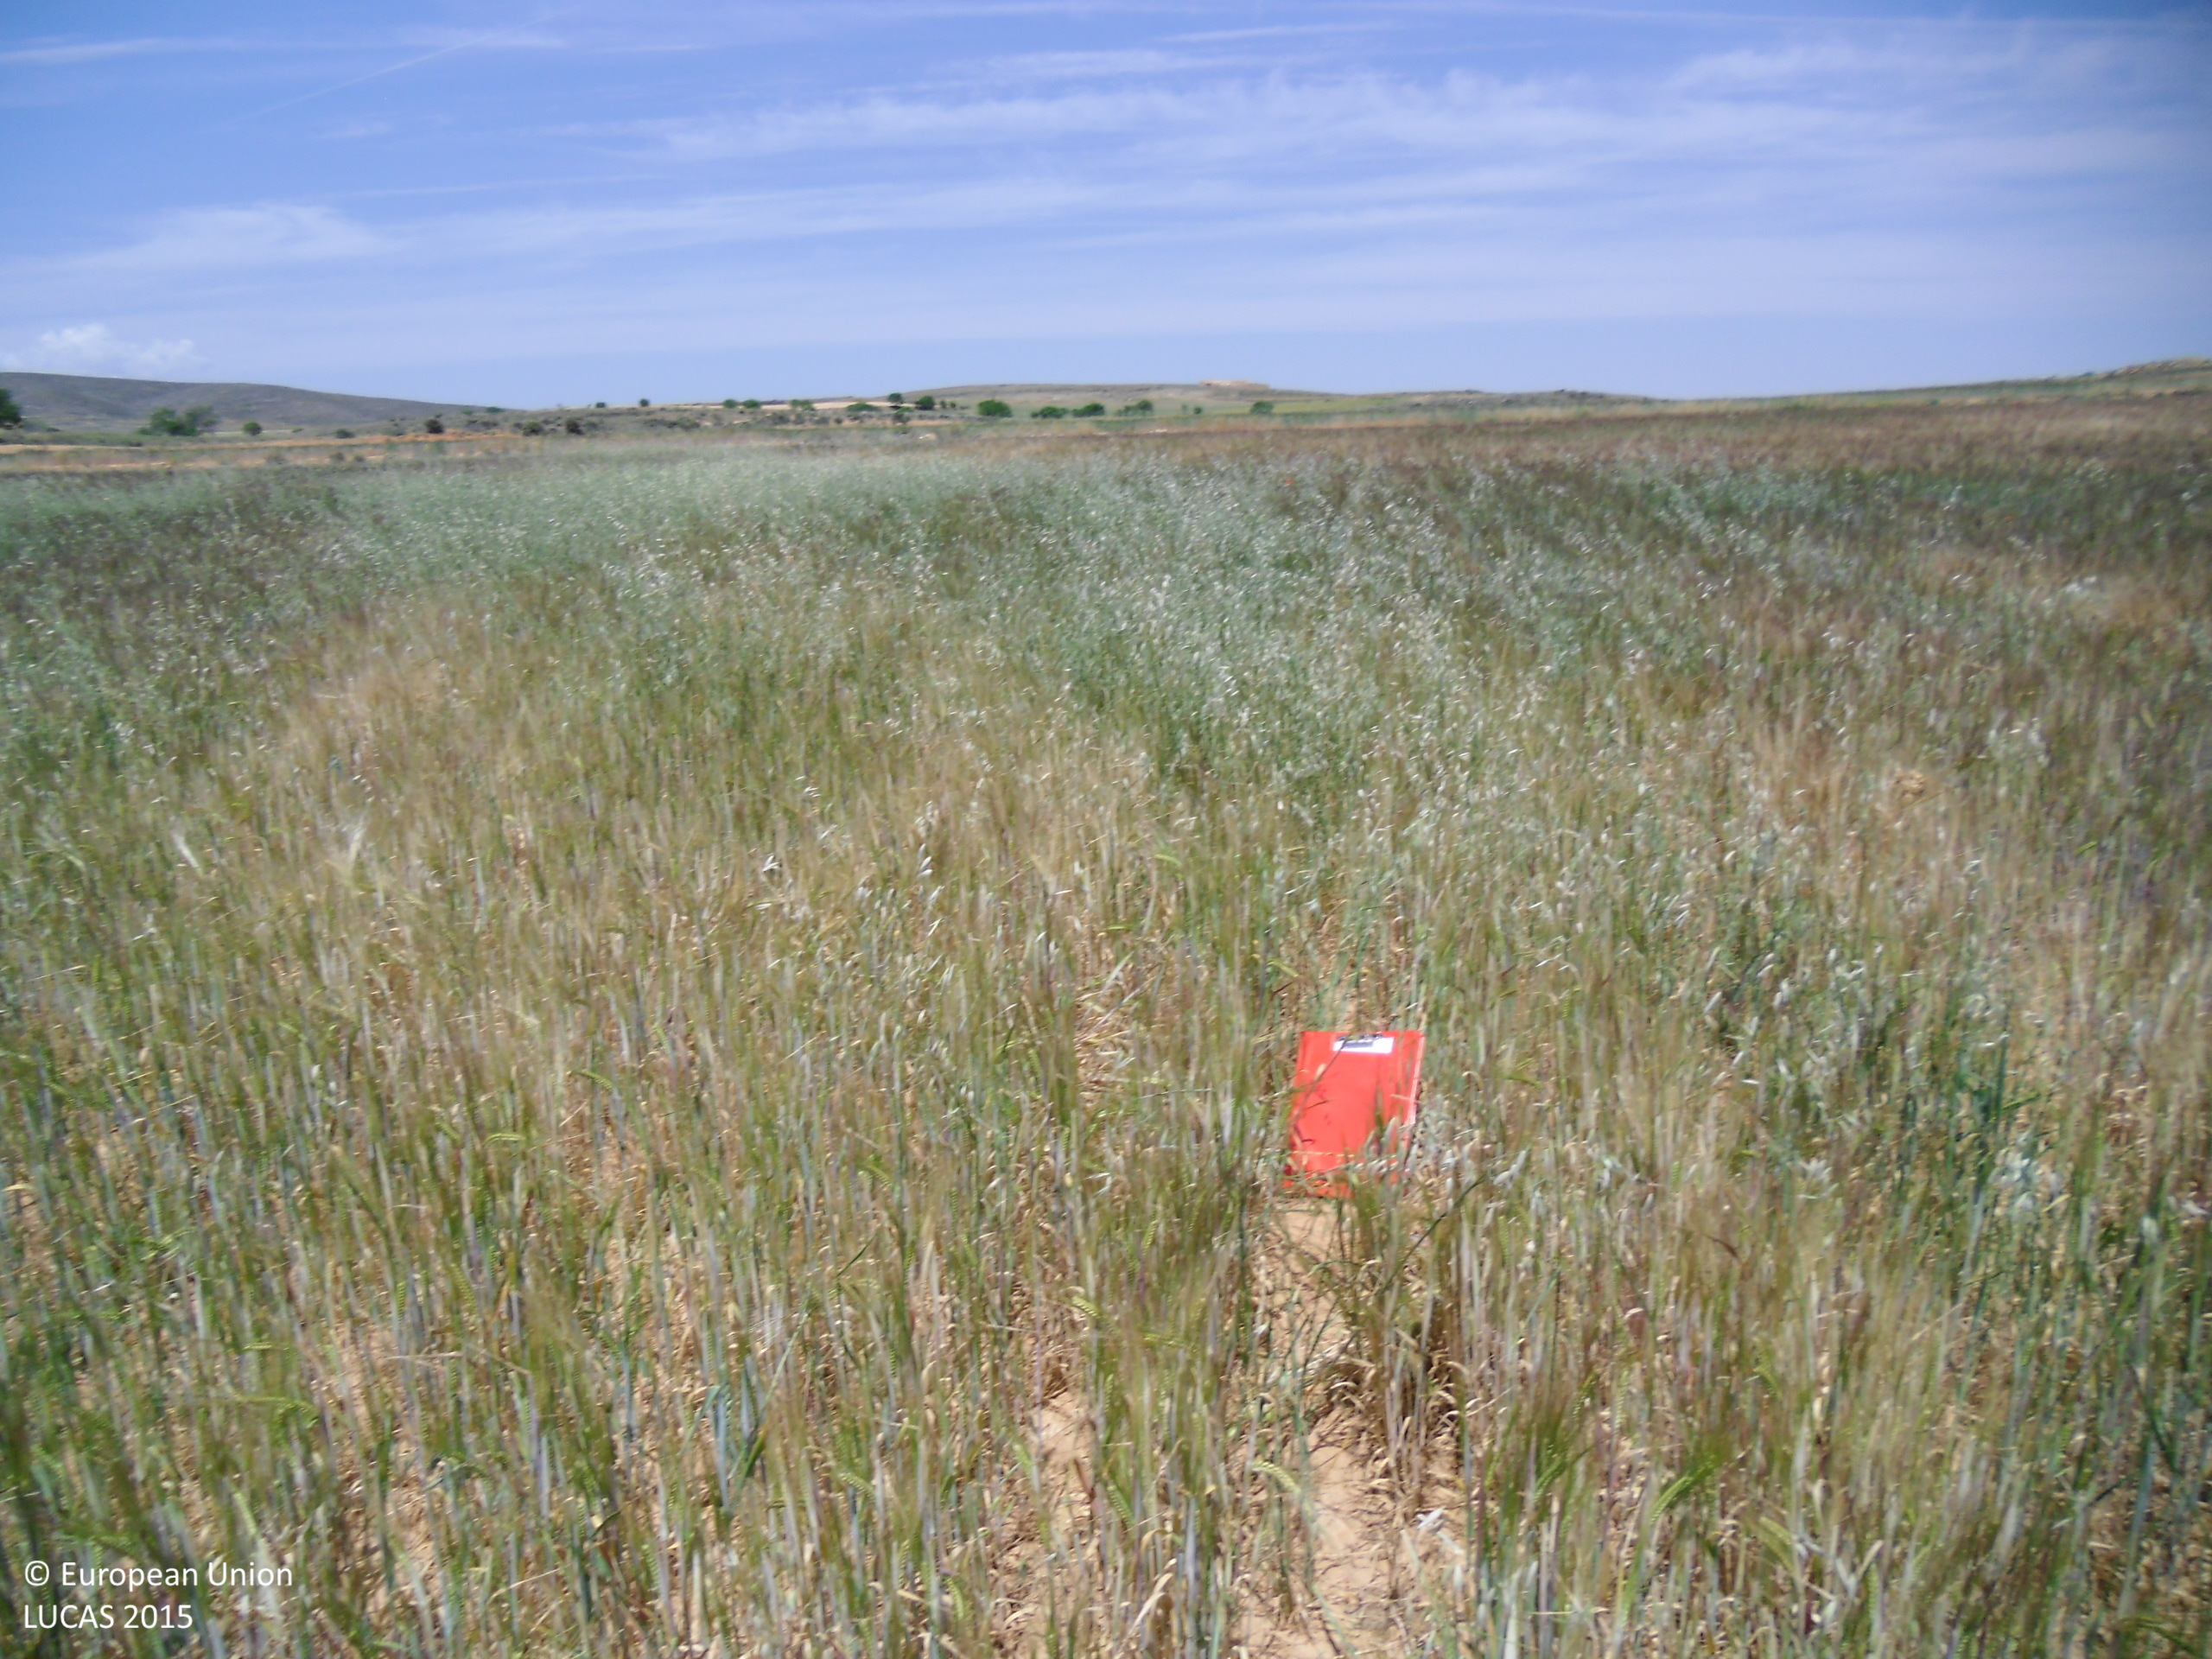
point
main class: Cropland
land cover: Barley
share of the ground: > 75 %
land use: Agriculture (excluding fallow land and kitchen gardens)
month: June
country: ES
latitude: 41.0847
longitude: -0.8606
